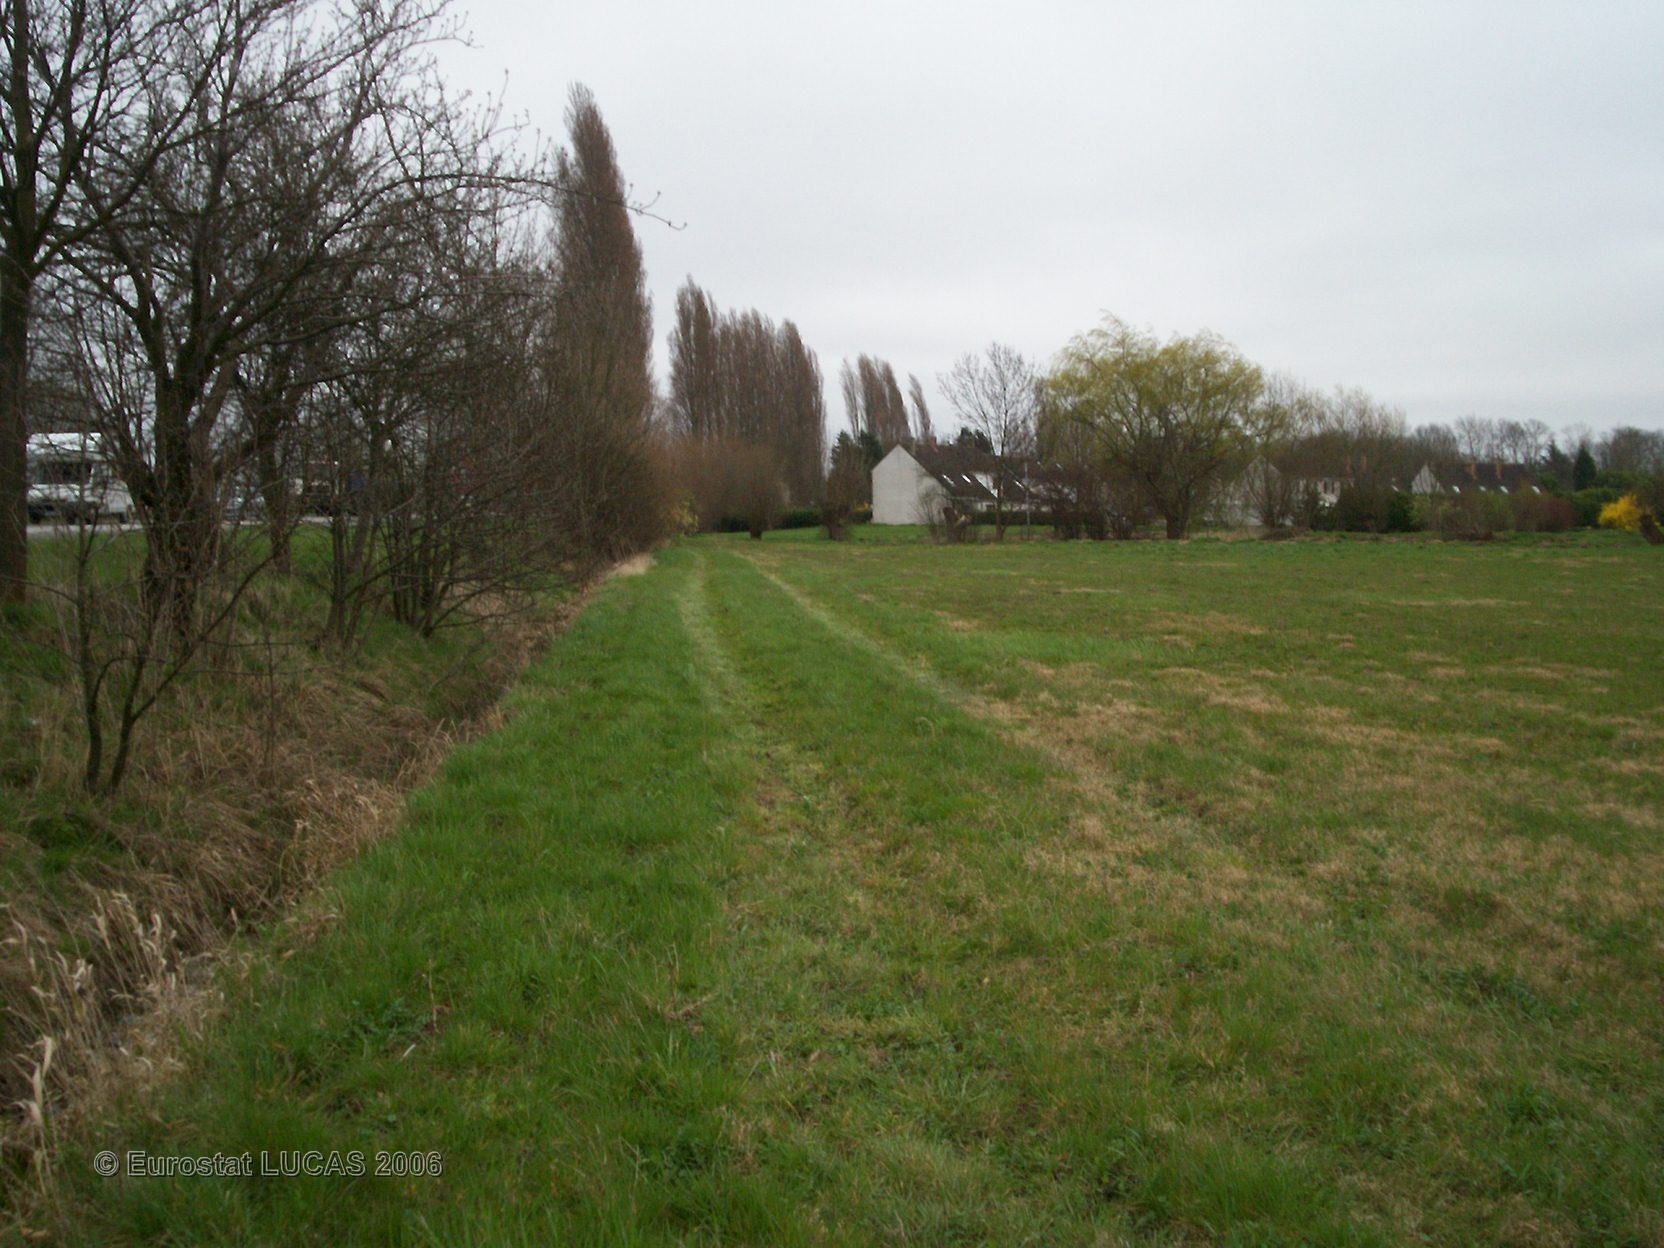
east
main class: Grassland
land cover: Grassland without tree/shrub cover
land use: Agriculture (excluding fallow land and kitchen gardens)
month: April
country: FR
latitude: 50.5685
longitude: 2.4902
